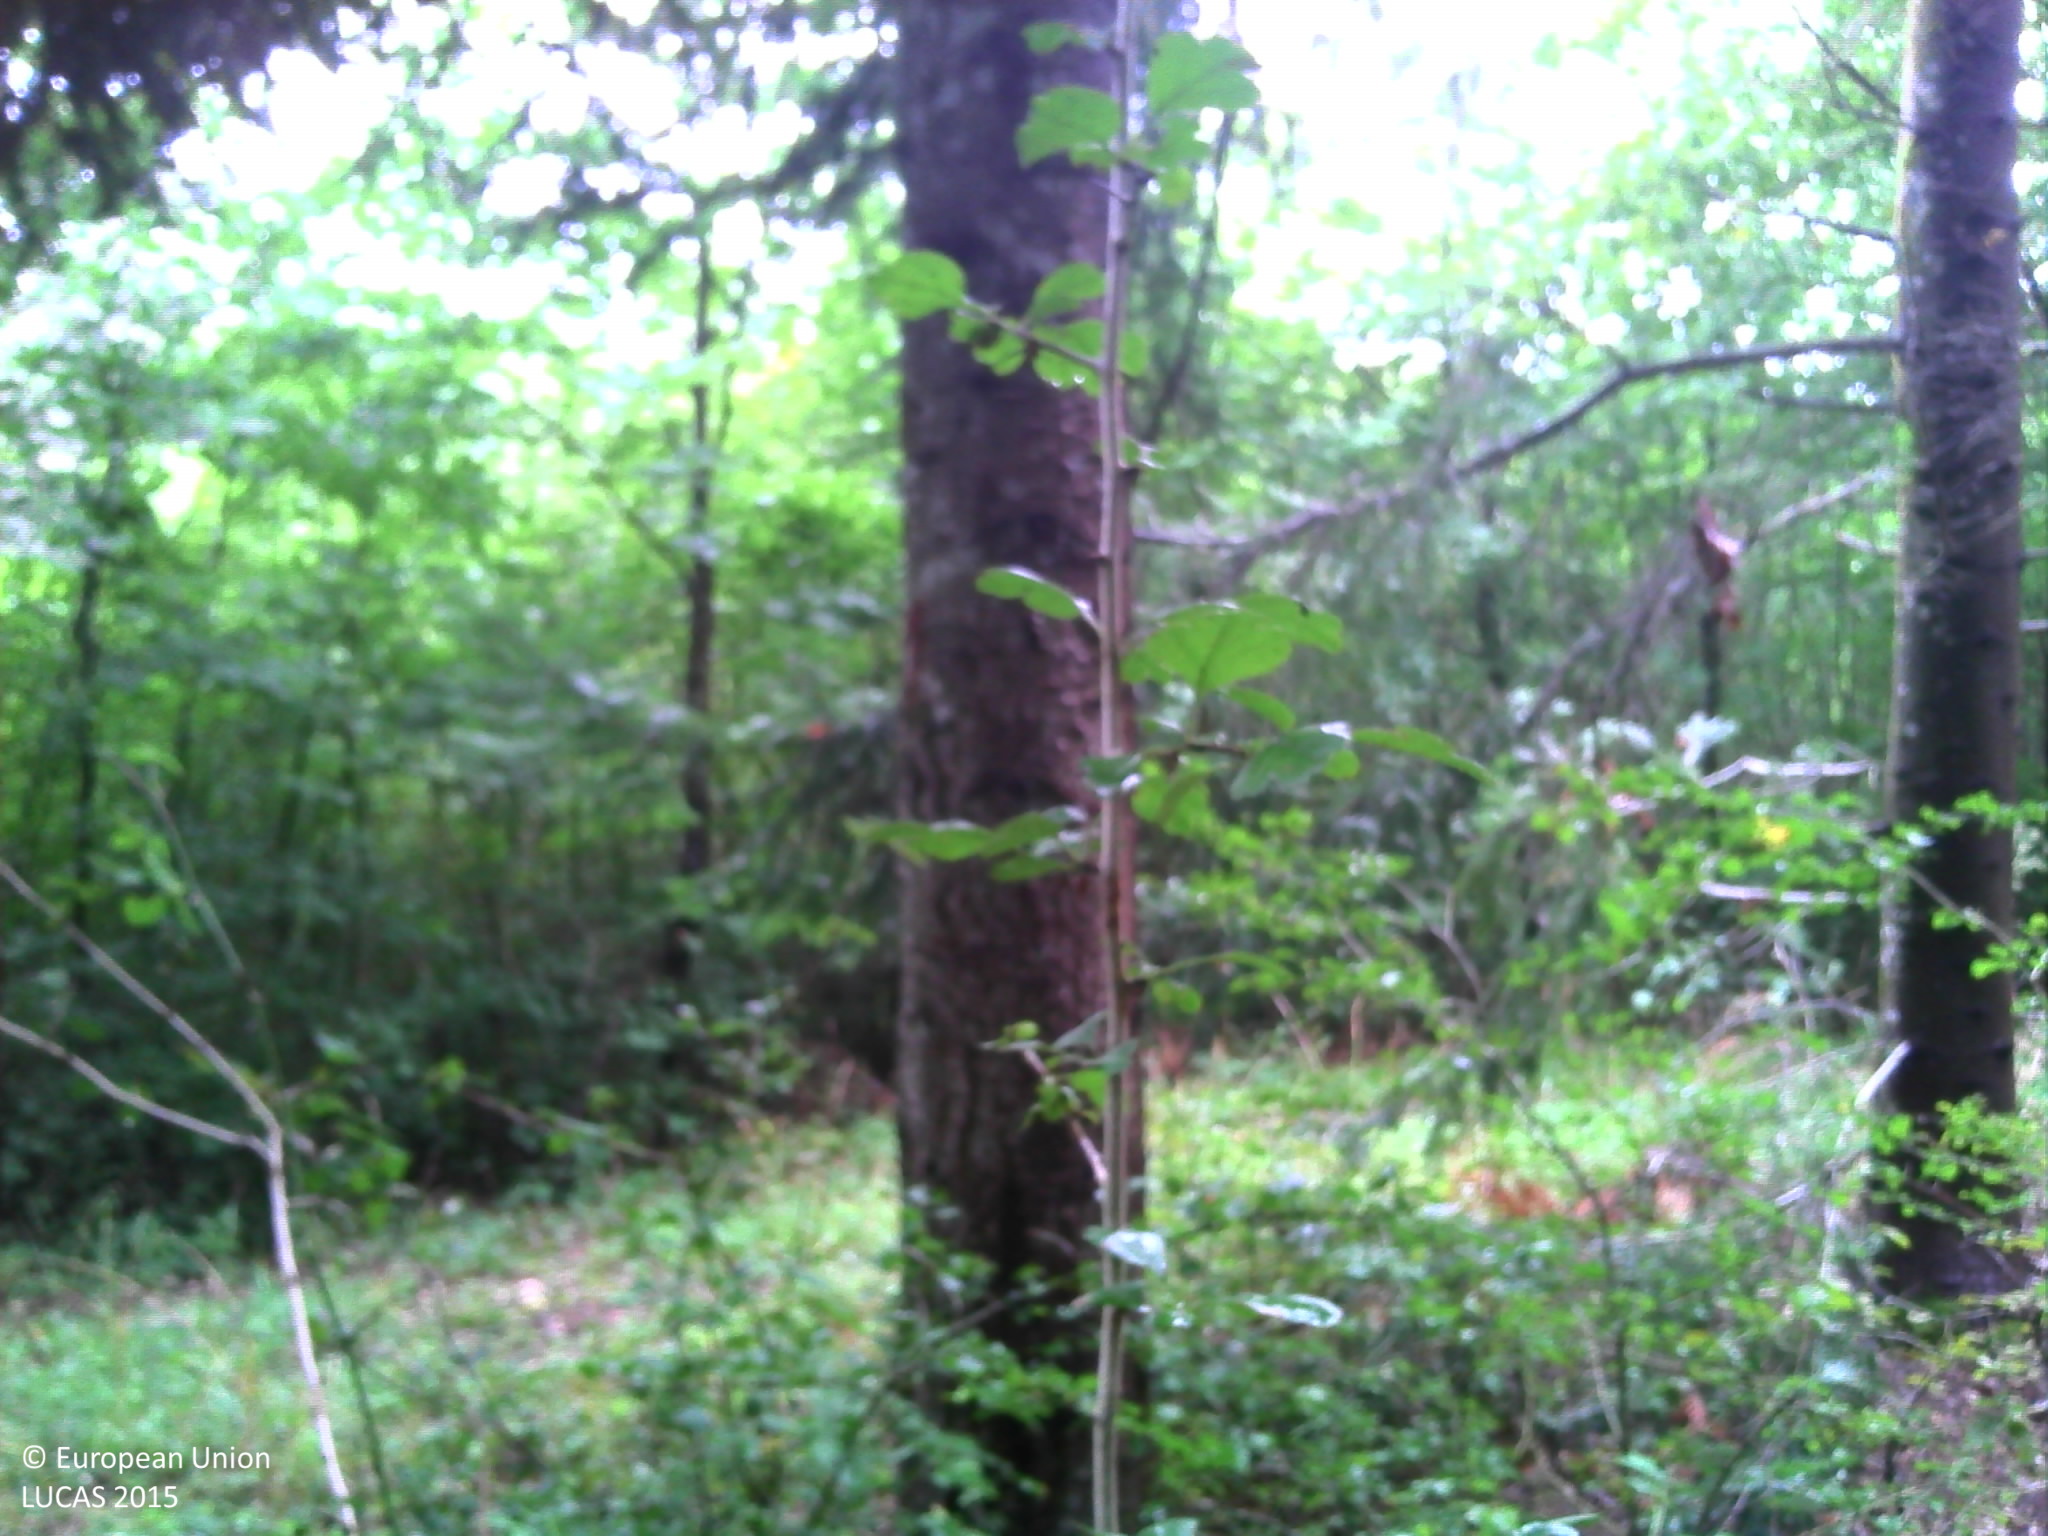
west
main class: Woodland
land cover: Other mixed woodland
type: exotic forest
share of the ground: > 75 %
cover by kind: coniferous forest trees 40 %, broadleaved forest trees 40 %, shrubs 10 %, herbaceous plants 10 %
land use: Forestry
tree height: > 5 m
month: September
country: FR
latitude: 47.1613
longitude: 4.7636
